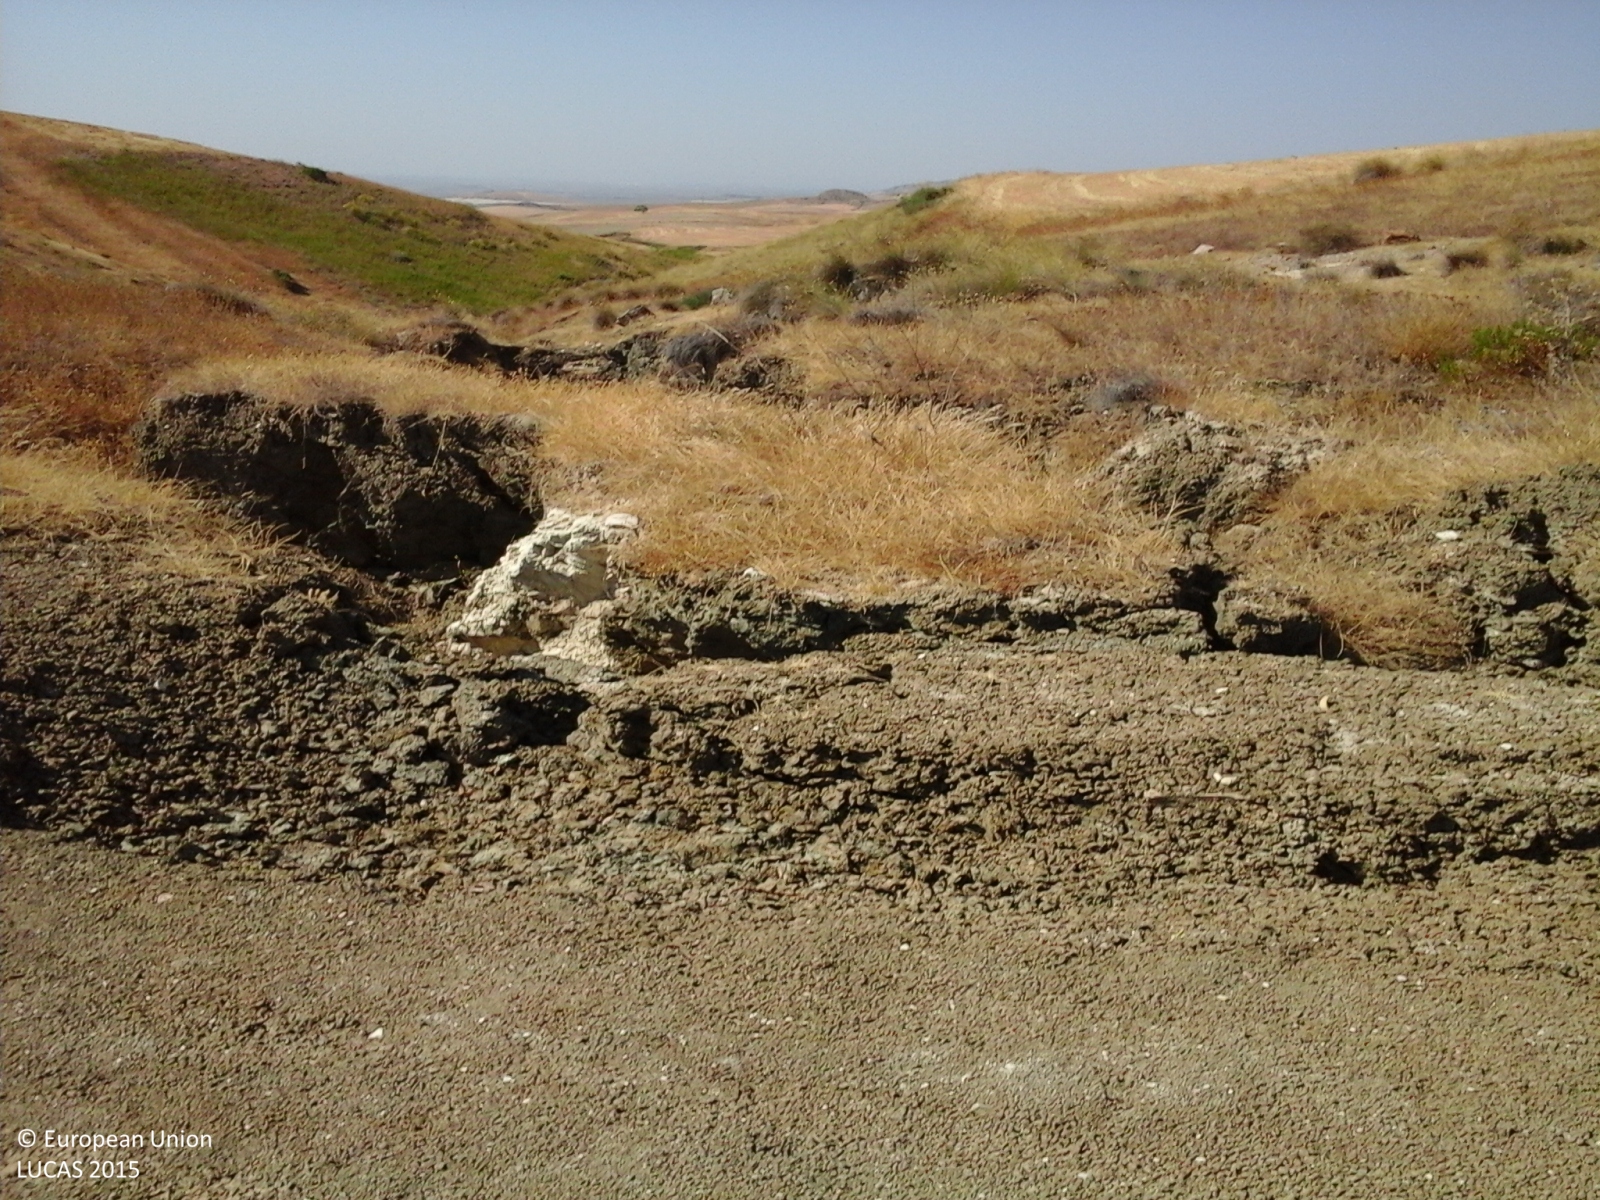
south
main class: Grassland
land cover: Grassland without tree/shrub cover
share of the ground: > 75 %
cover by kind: herbaceous plants 100 %
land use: Agriculture (excluding fallow land and kitchen gardens)
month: July
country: IT
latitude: 37.1945
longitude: 14.3263
